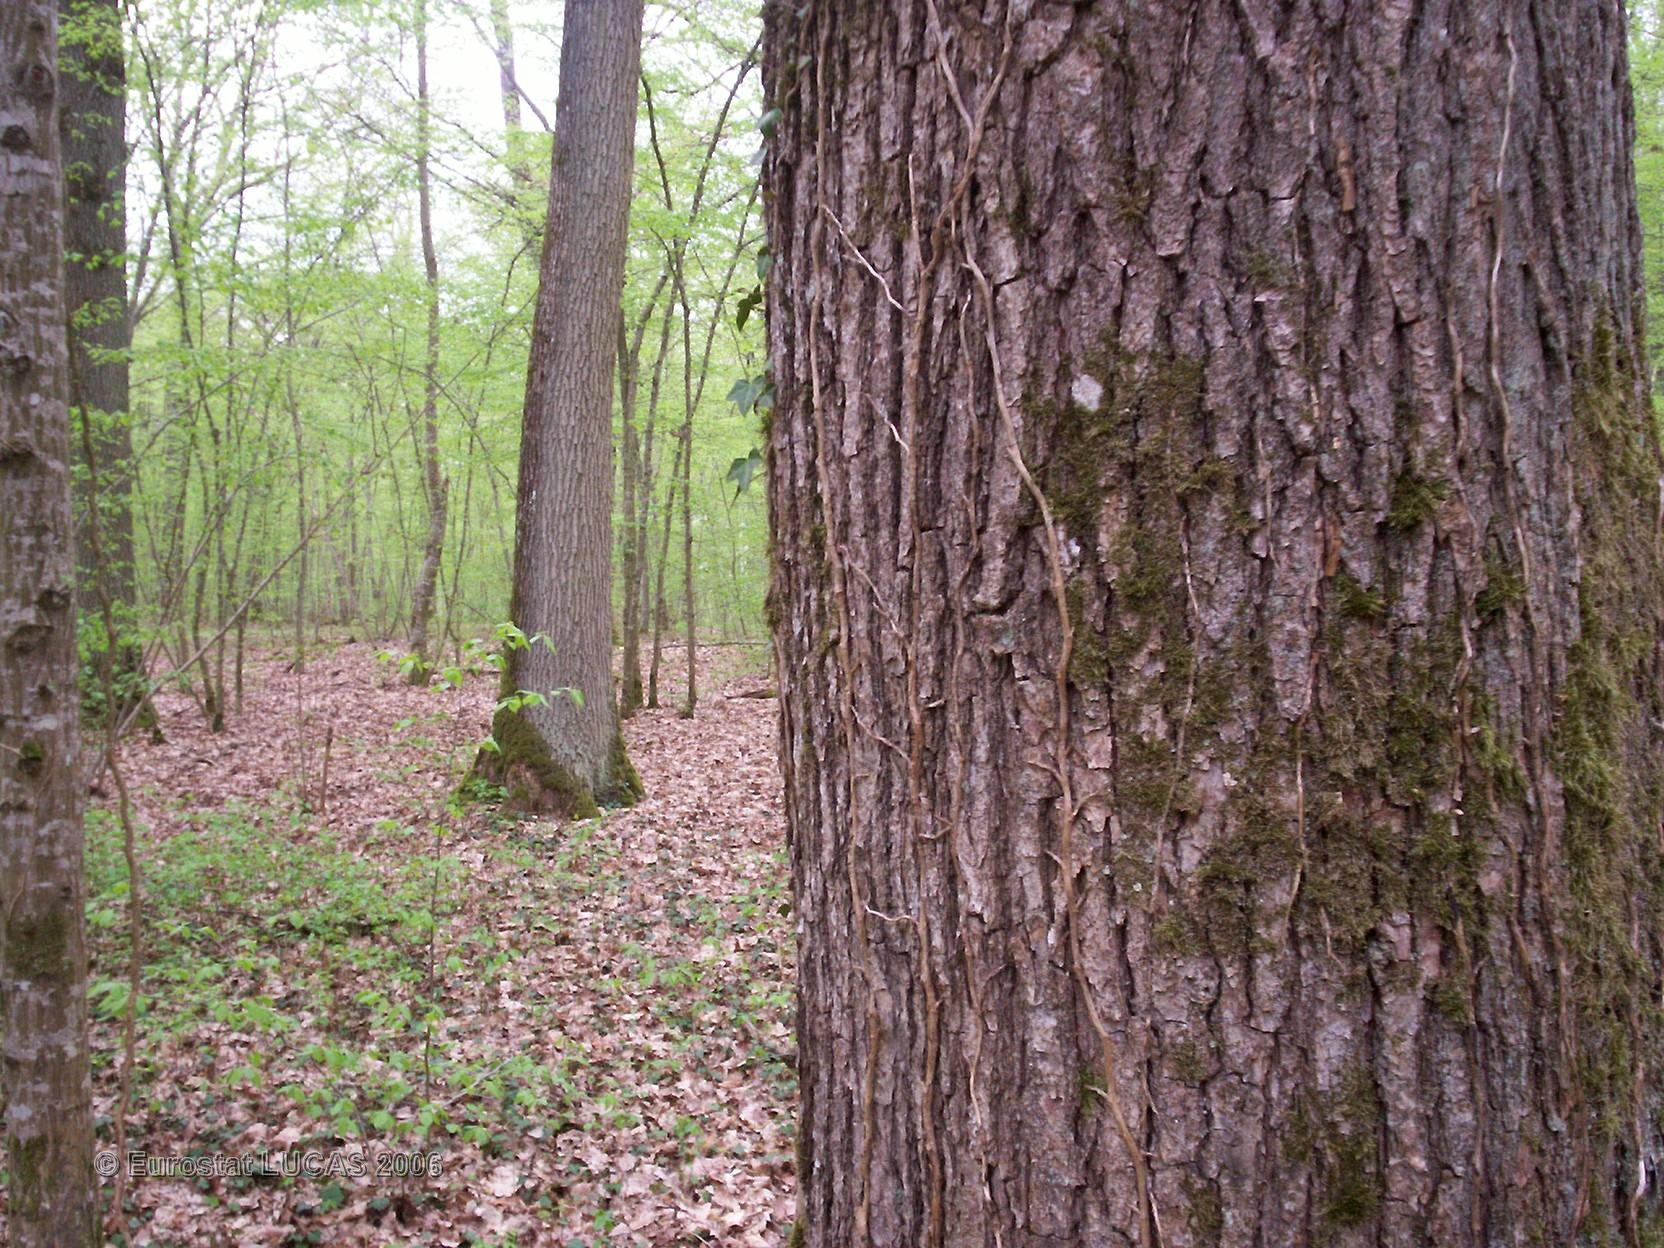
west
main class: Woodland
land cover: Broadleaved forest
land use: Forestry
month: April
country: FR
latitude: 48.3309
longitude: 5.9940
